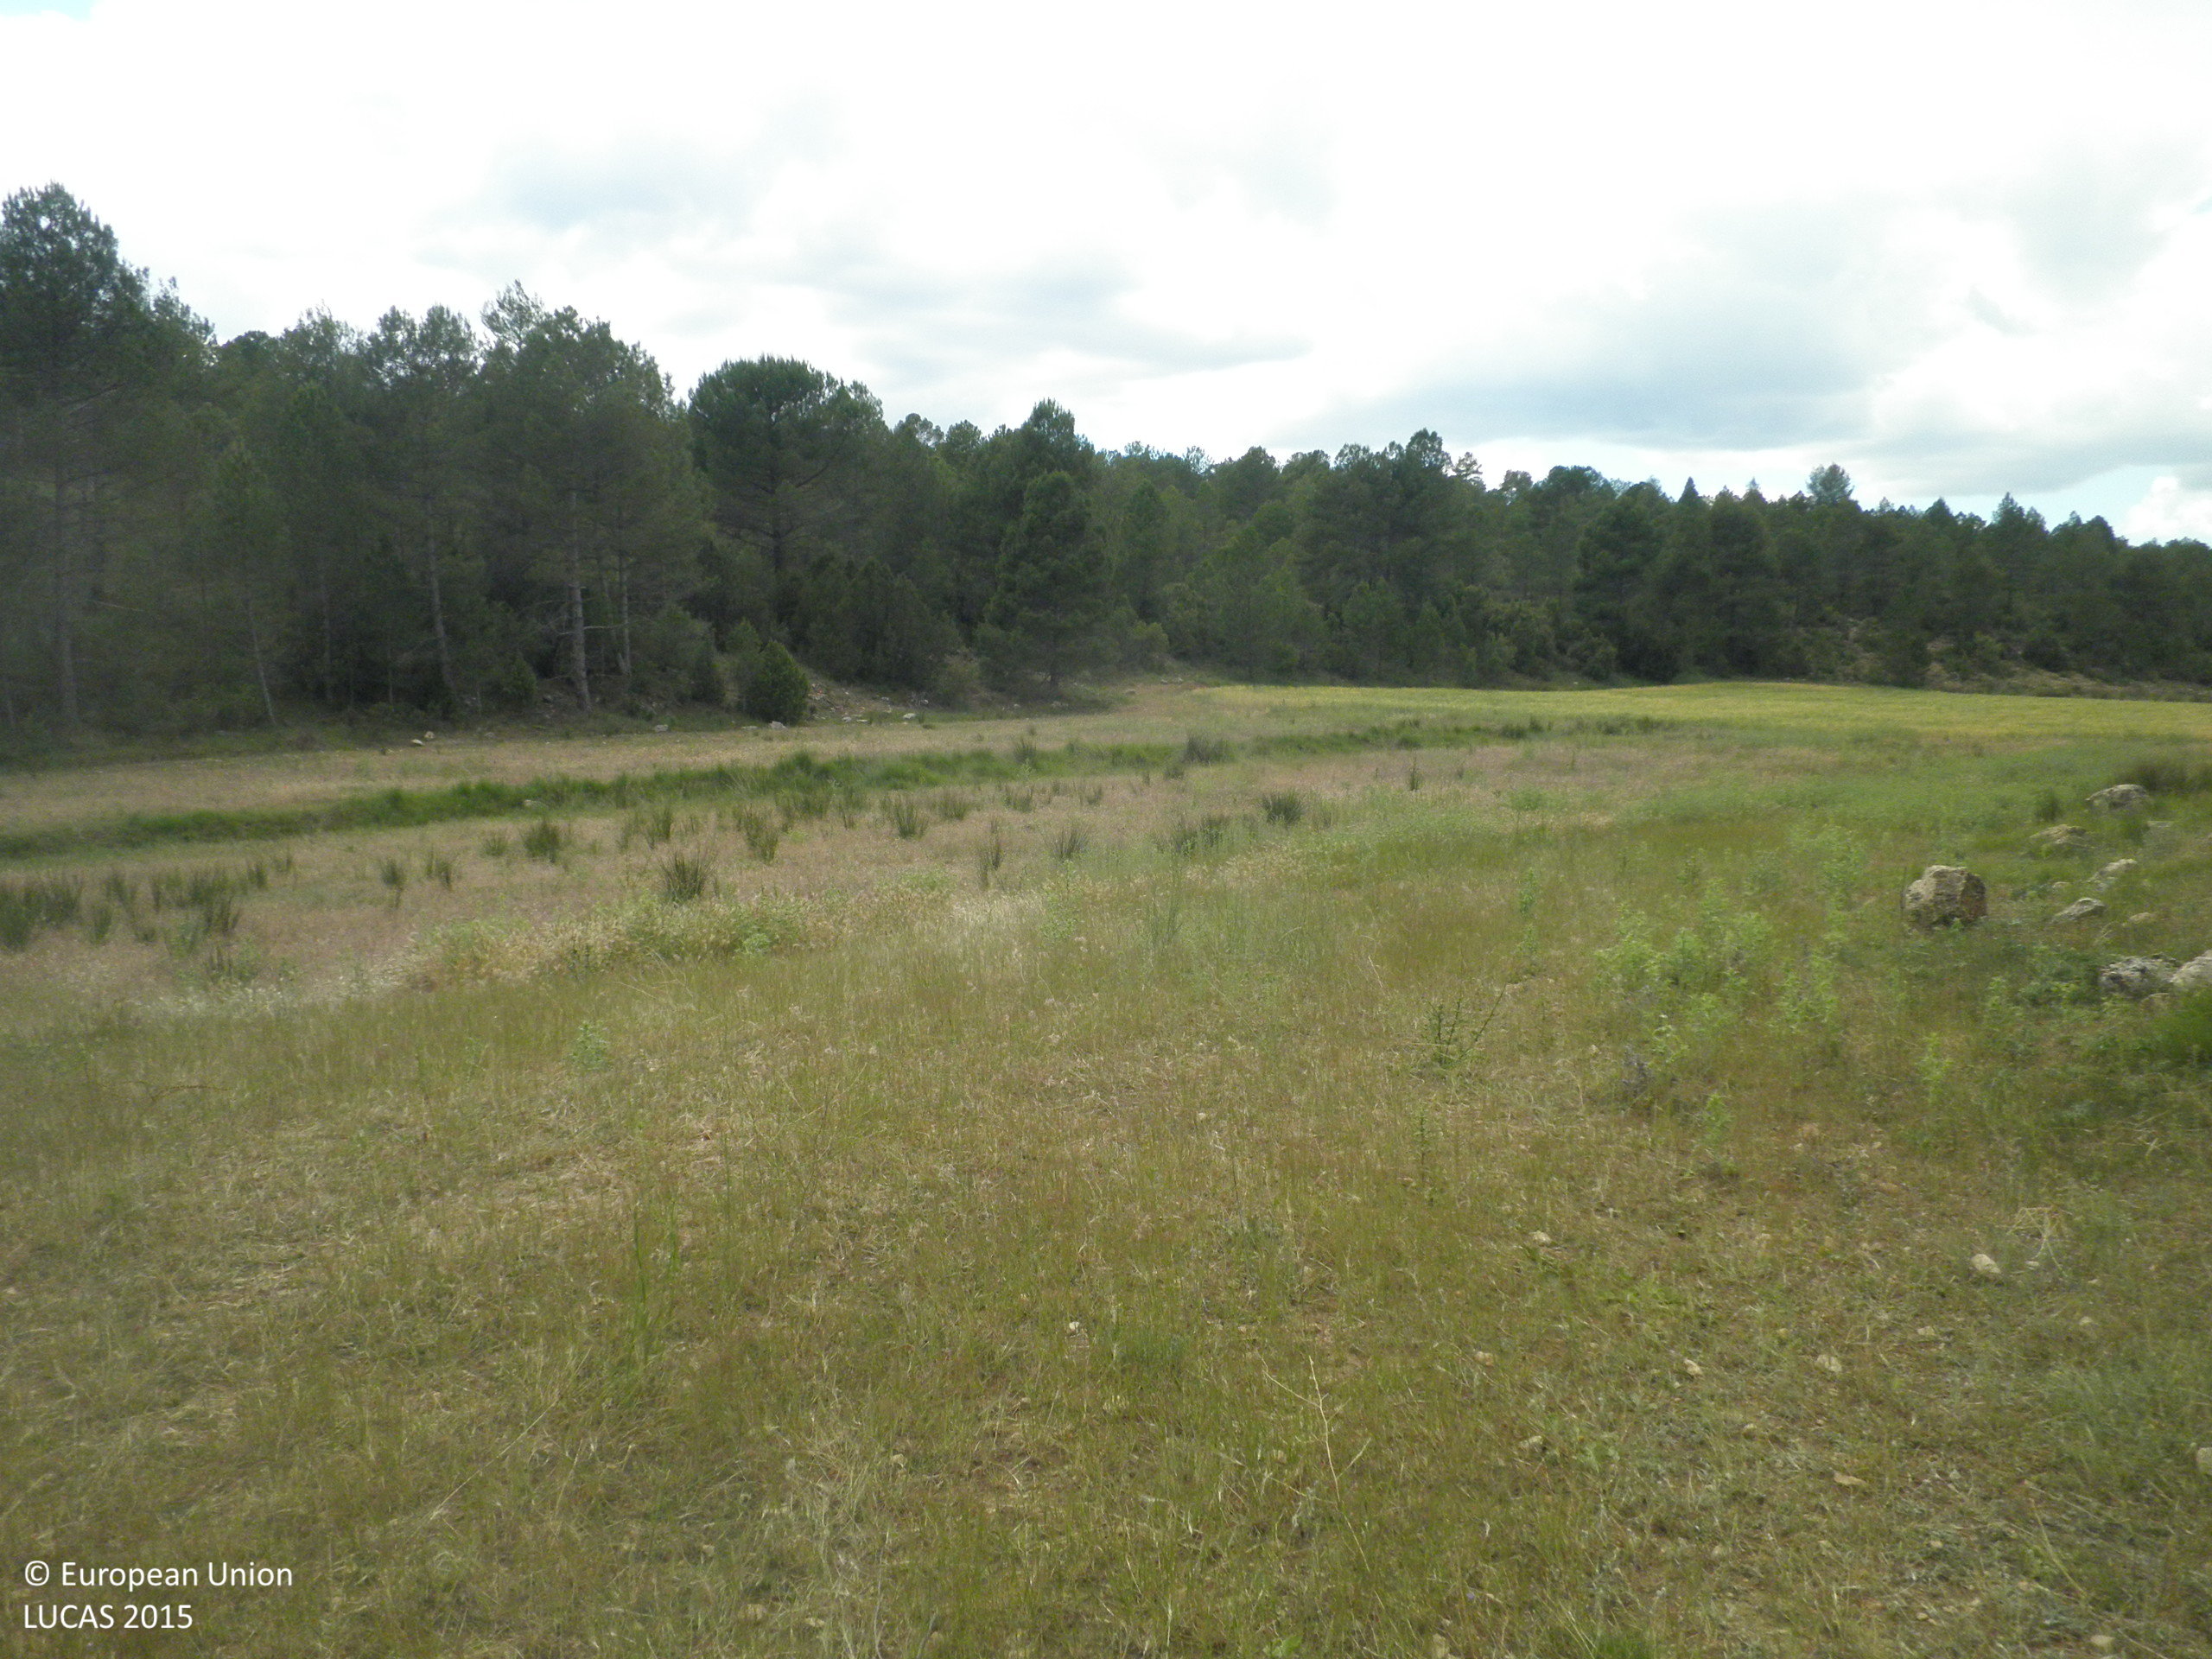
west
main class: Grassland
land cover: Spontaneously vegetated surfaces
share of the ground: > 75 %
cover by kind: herbaceous plants 90 %, unconsolidated bare surface 10 %
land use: Abandoned areas
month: June
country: ES
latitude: 39.7966
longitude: -1.7464
